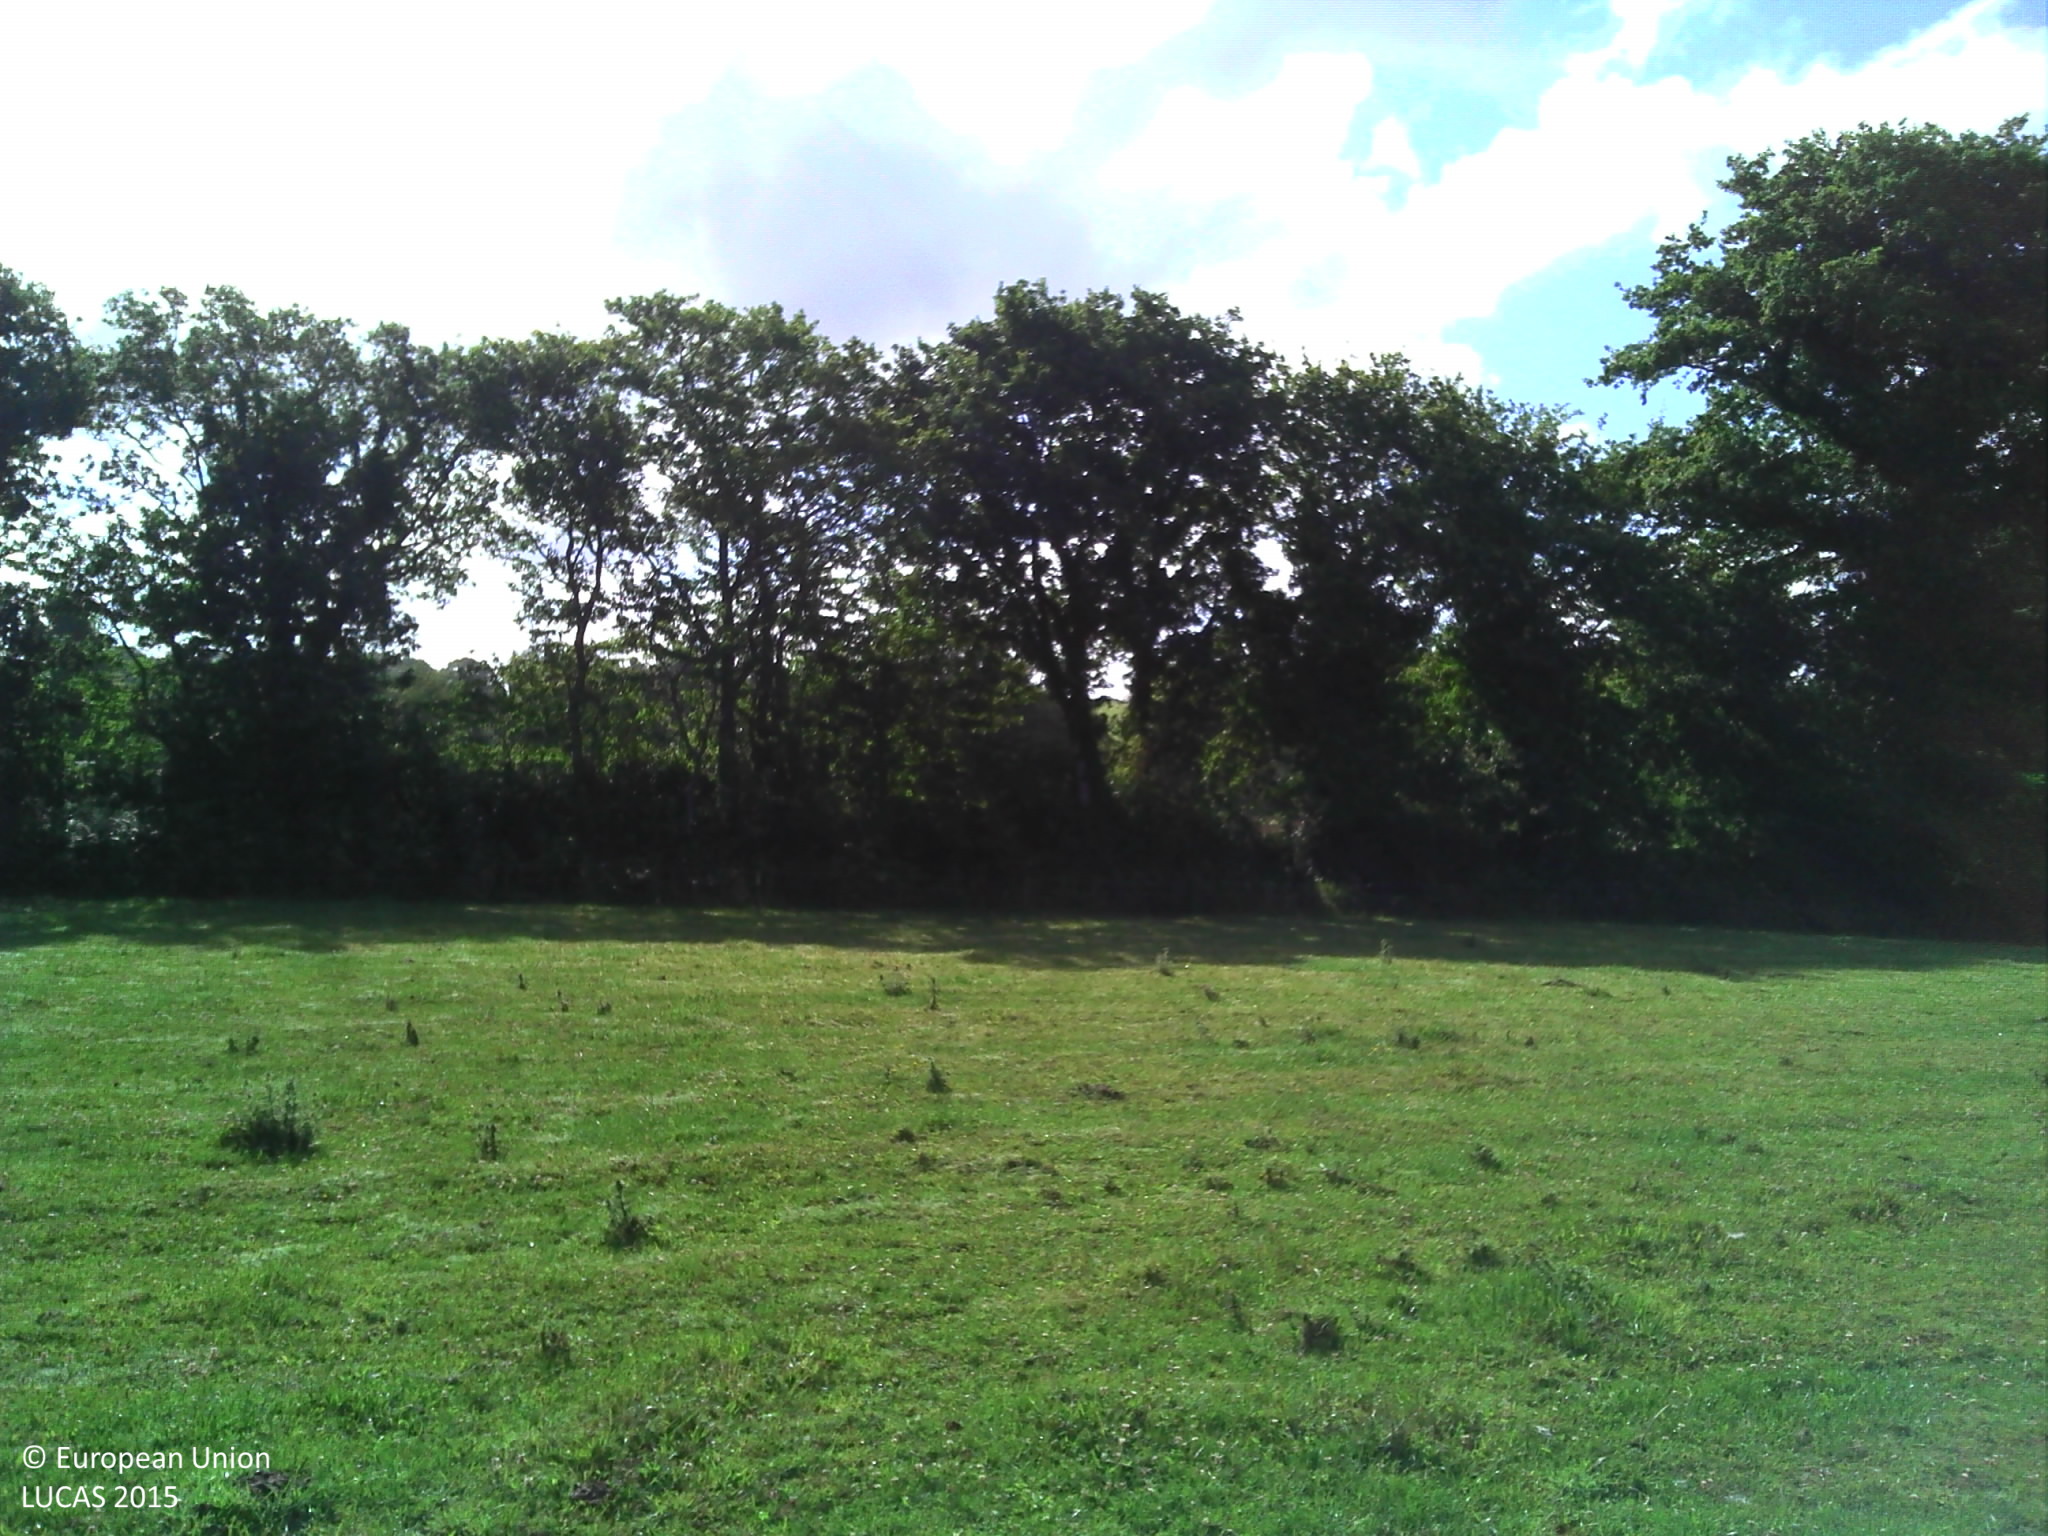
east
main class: Grassland
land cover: Grassland without tree/shrub cover
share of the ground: > 75 %
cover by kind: herbaceous plants 100 %
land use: Agriculture (excluding fallow land and kitchen gardens)
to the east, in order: Grassland without tree/shrub cover; Fences; Lines of trees; Grassland without tree/shrub cover; Lines of trees; Grassland without tree/shrub cover; Lines of trees; Grassland without tree/shrub cover
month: July
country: FR
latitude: 48.1910
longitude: -3.3522
